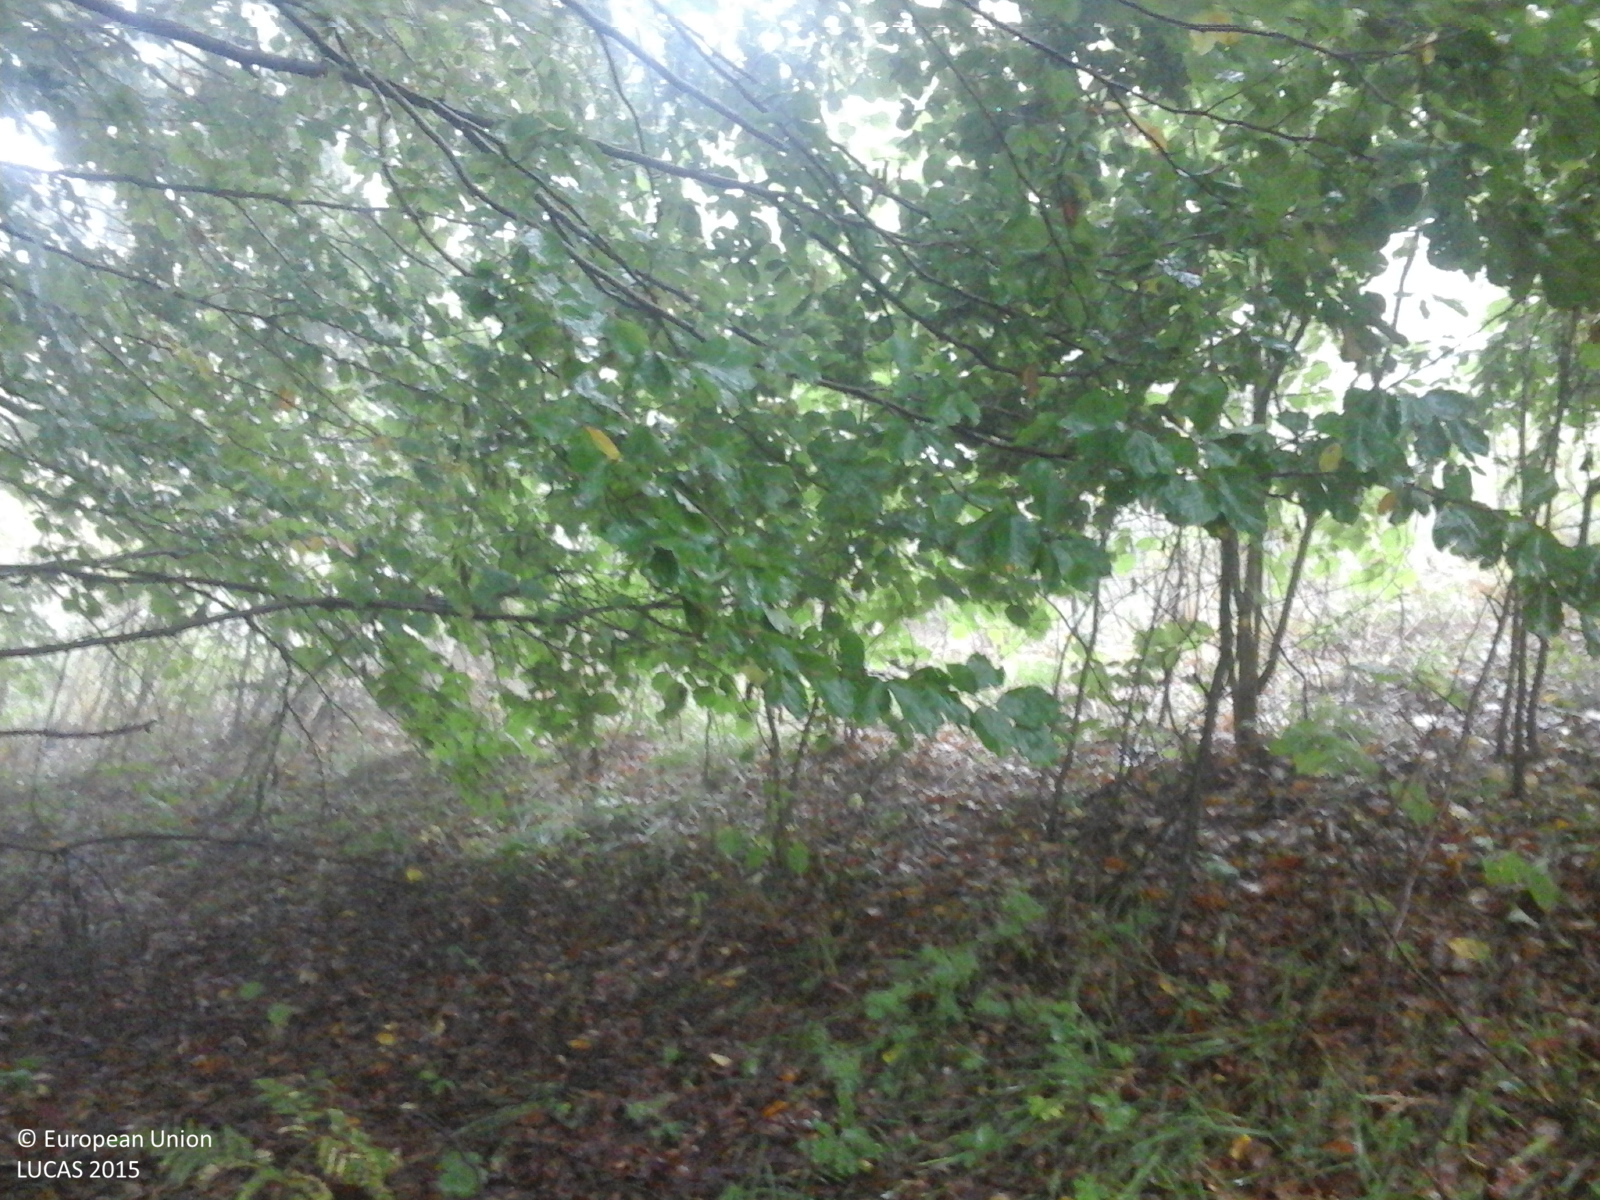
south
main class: Woodland
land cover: Broadleaved woodland
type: mesophytic deciduous forest
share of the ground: > 75 %
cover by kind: broadleaved forest trees 100 %
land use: Forestry
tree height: > 5 m
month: September
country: RO
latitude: 45.3879
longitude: 24.0037
